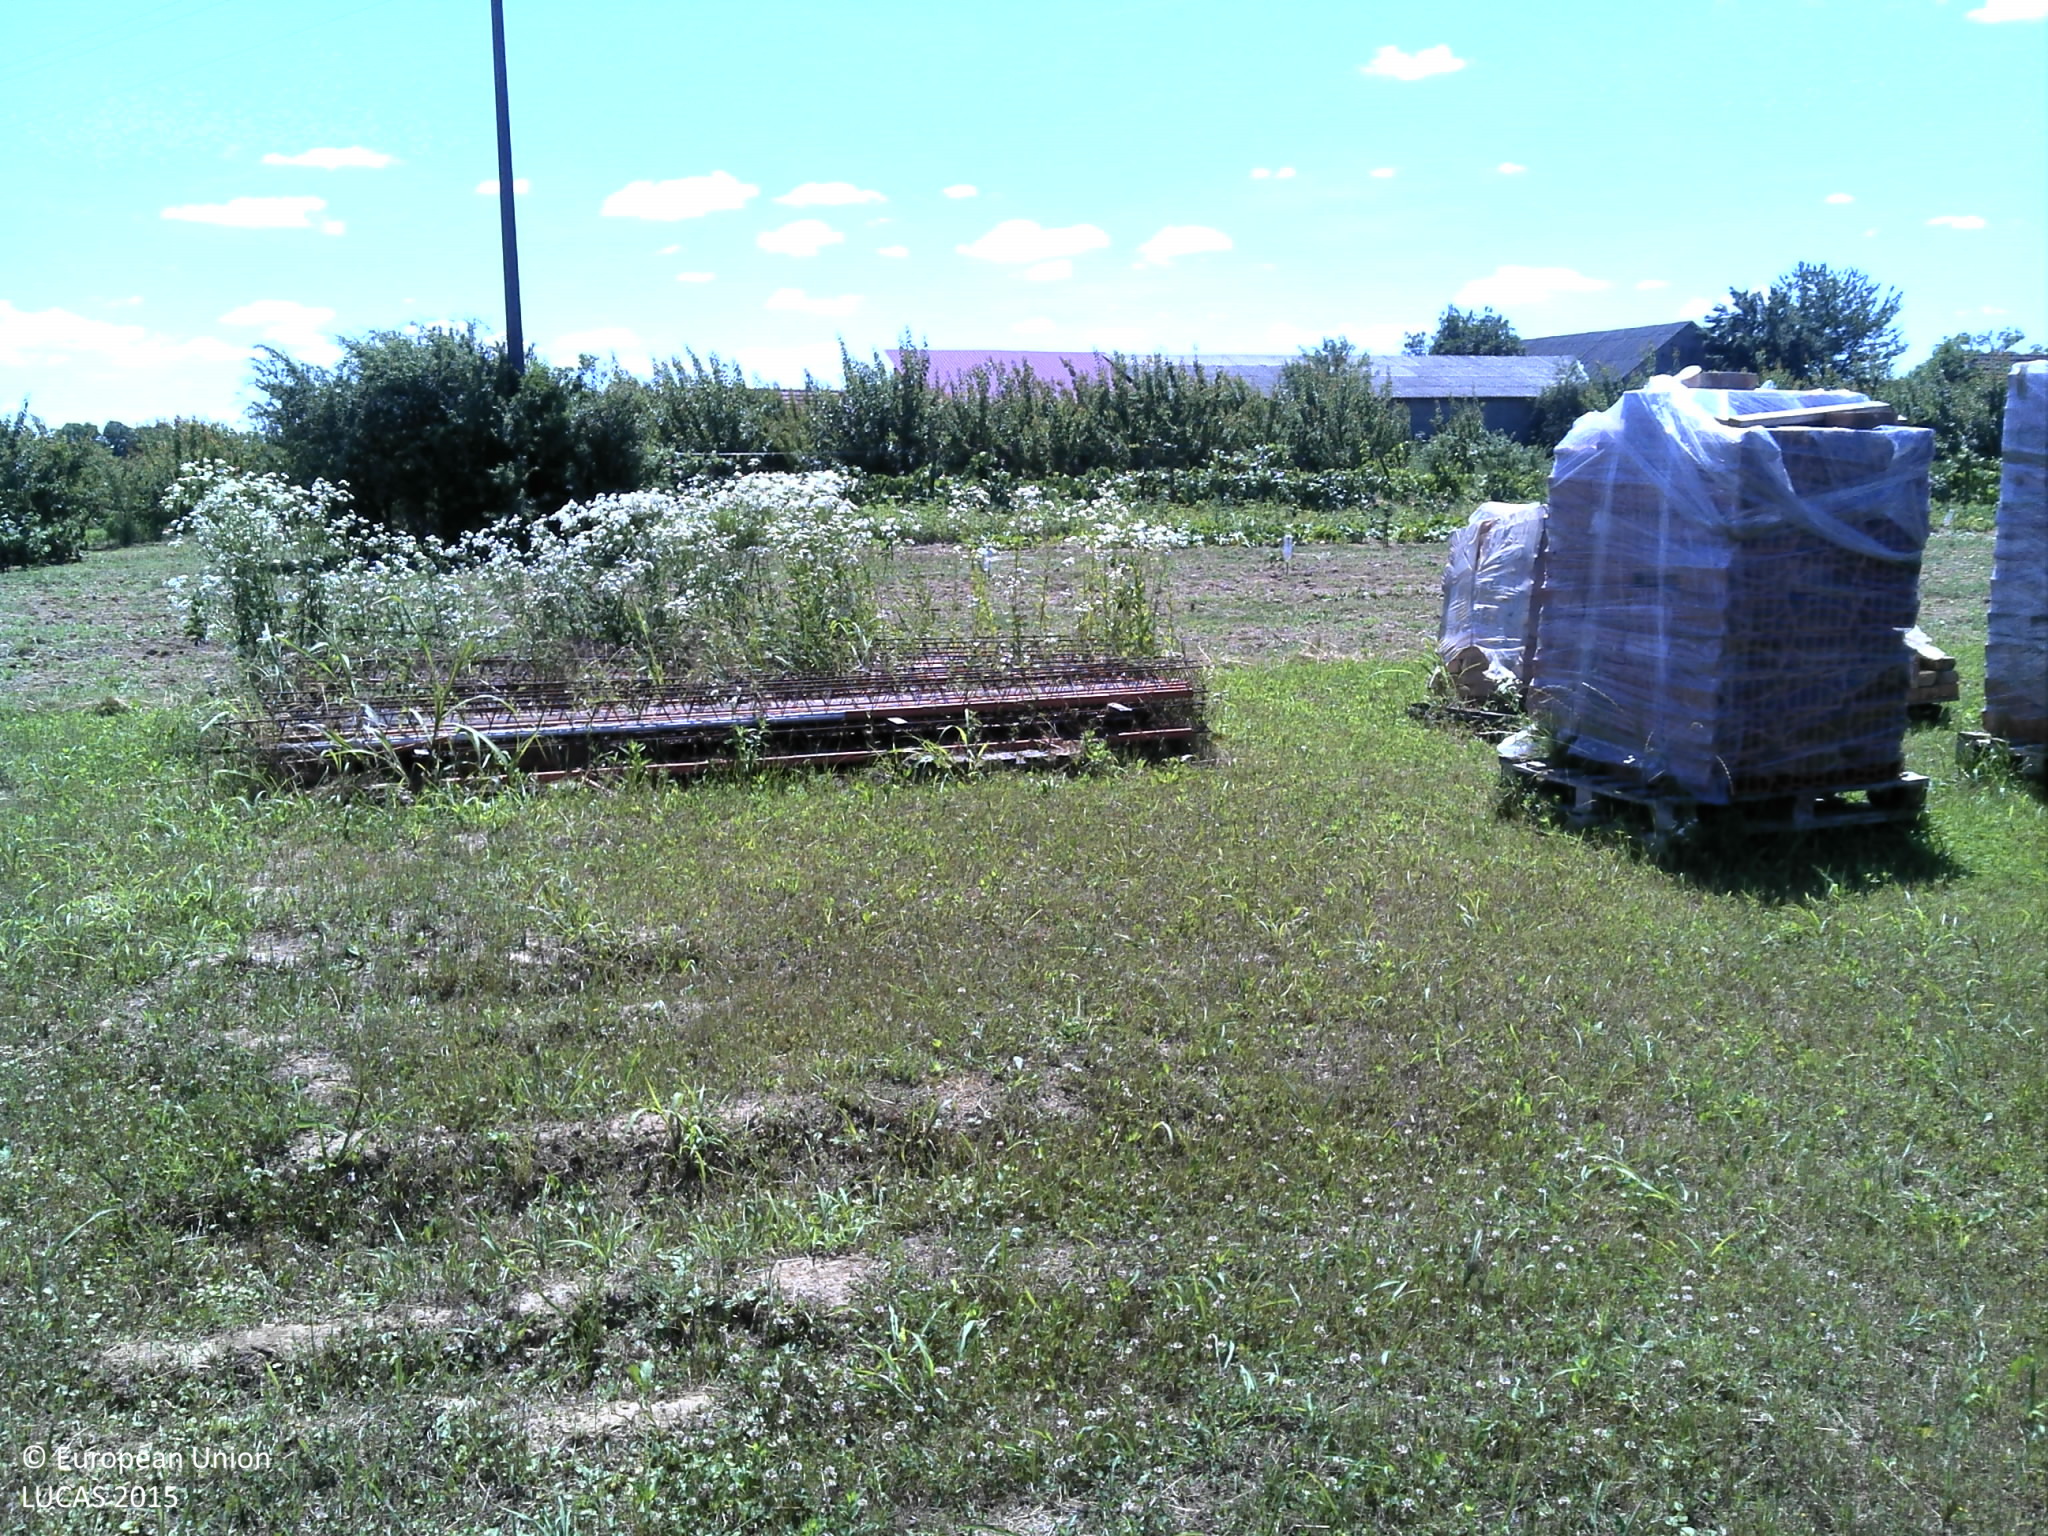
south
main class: Grassland
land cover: Grassland without tree/shrub cover
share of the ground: > 75 %
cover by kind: herbaceous plants 100 %
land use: Semi-natural and natural areas not in use
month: June
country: HR
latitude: 45.7567
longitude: 18.0659
